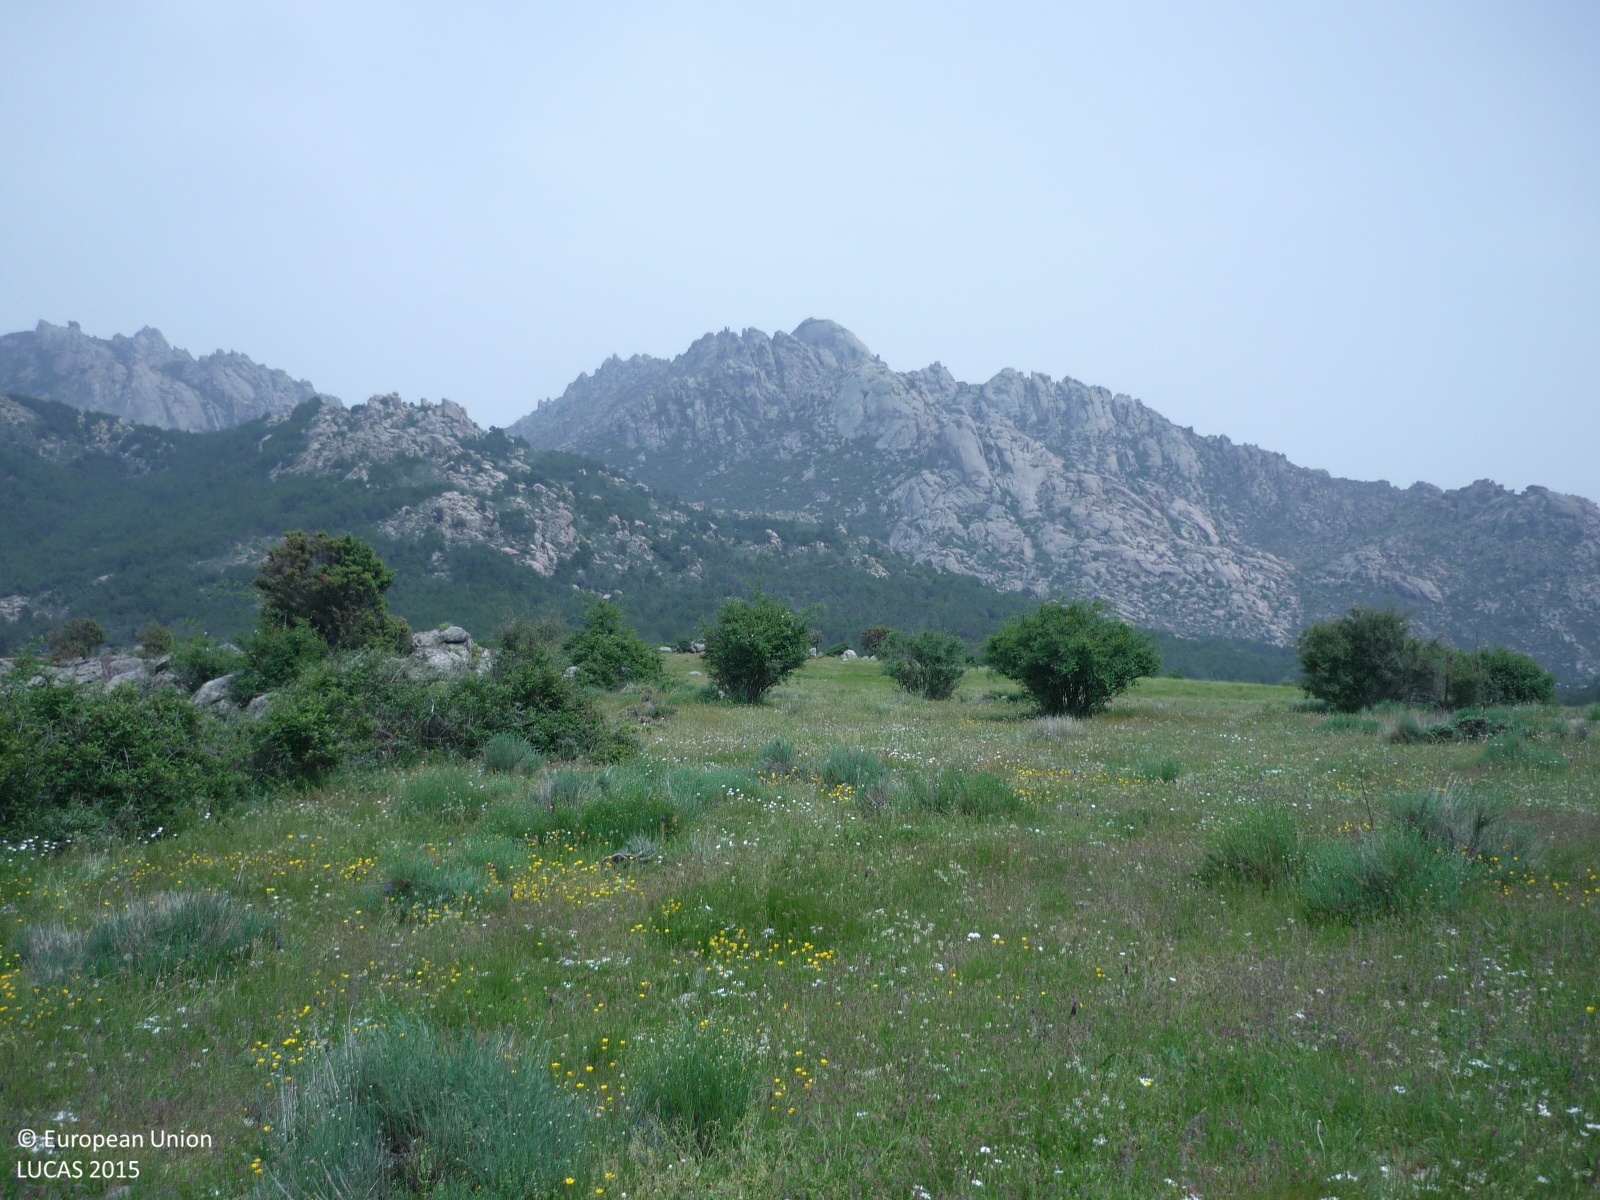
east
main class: Grassland
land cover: Grassland without tree/shrub cover
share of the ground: > 75 %
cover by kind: herbaceous plants 90 %, shrubs 5 %, unconsolidated bare surface 5 %
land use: Agriculture (excluding fallow land and kitchen gardens)
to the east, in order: Grassland without tree/shrub cover; Grassland with sparse tree/shrub cover; Other bare soil; Tracks; Other bare soil; Fences; Grassland without tree/shrub cover; Grassland with sparse tree/shrub cover
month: May
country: ES
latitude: 40.7546
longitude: -3.9149
